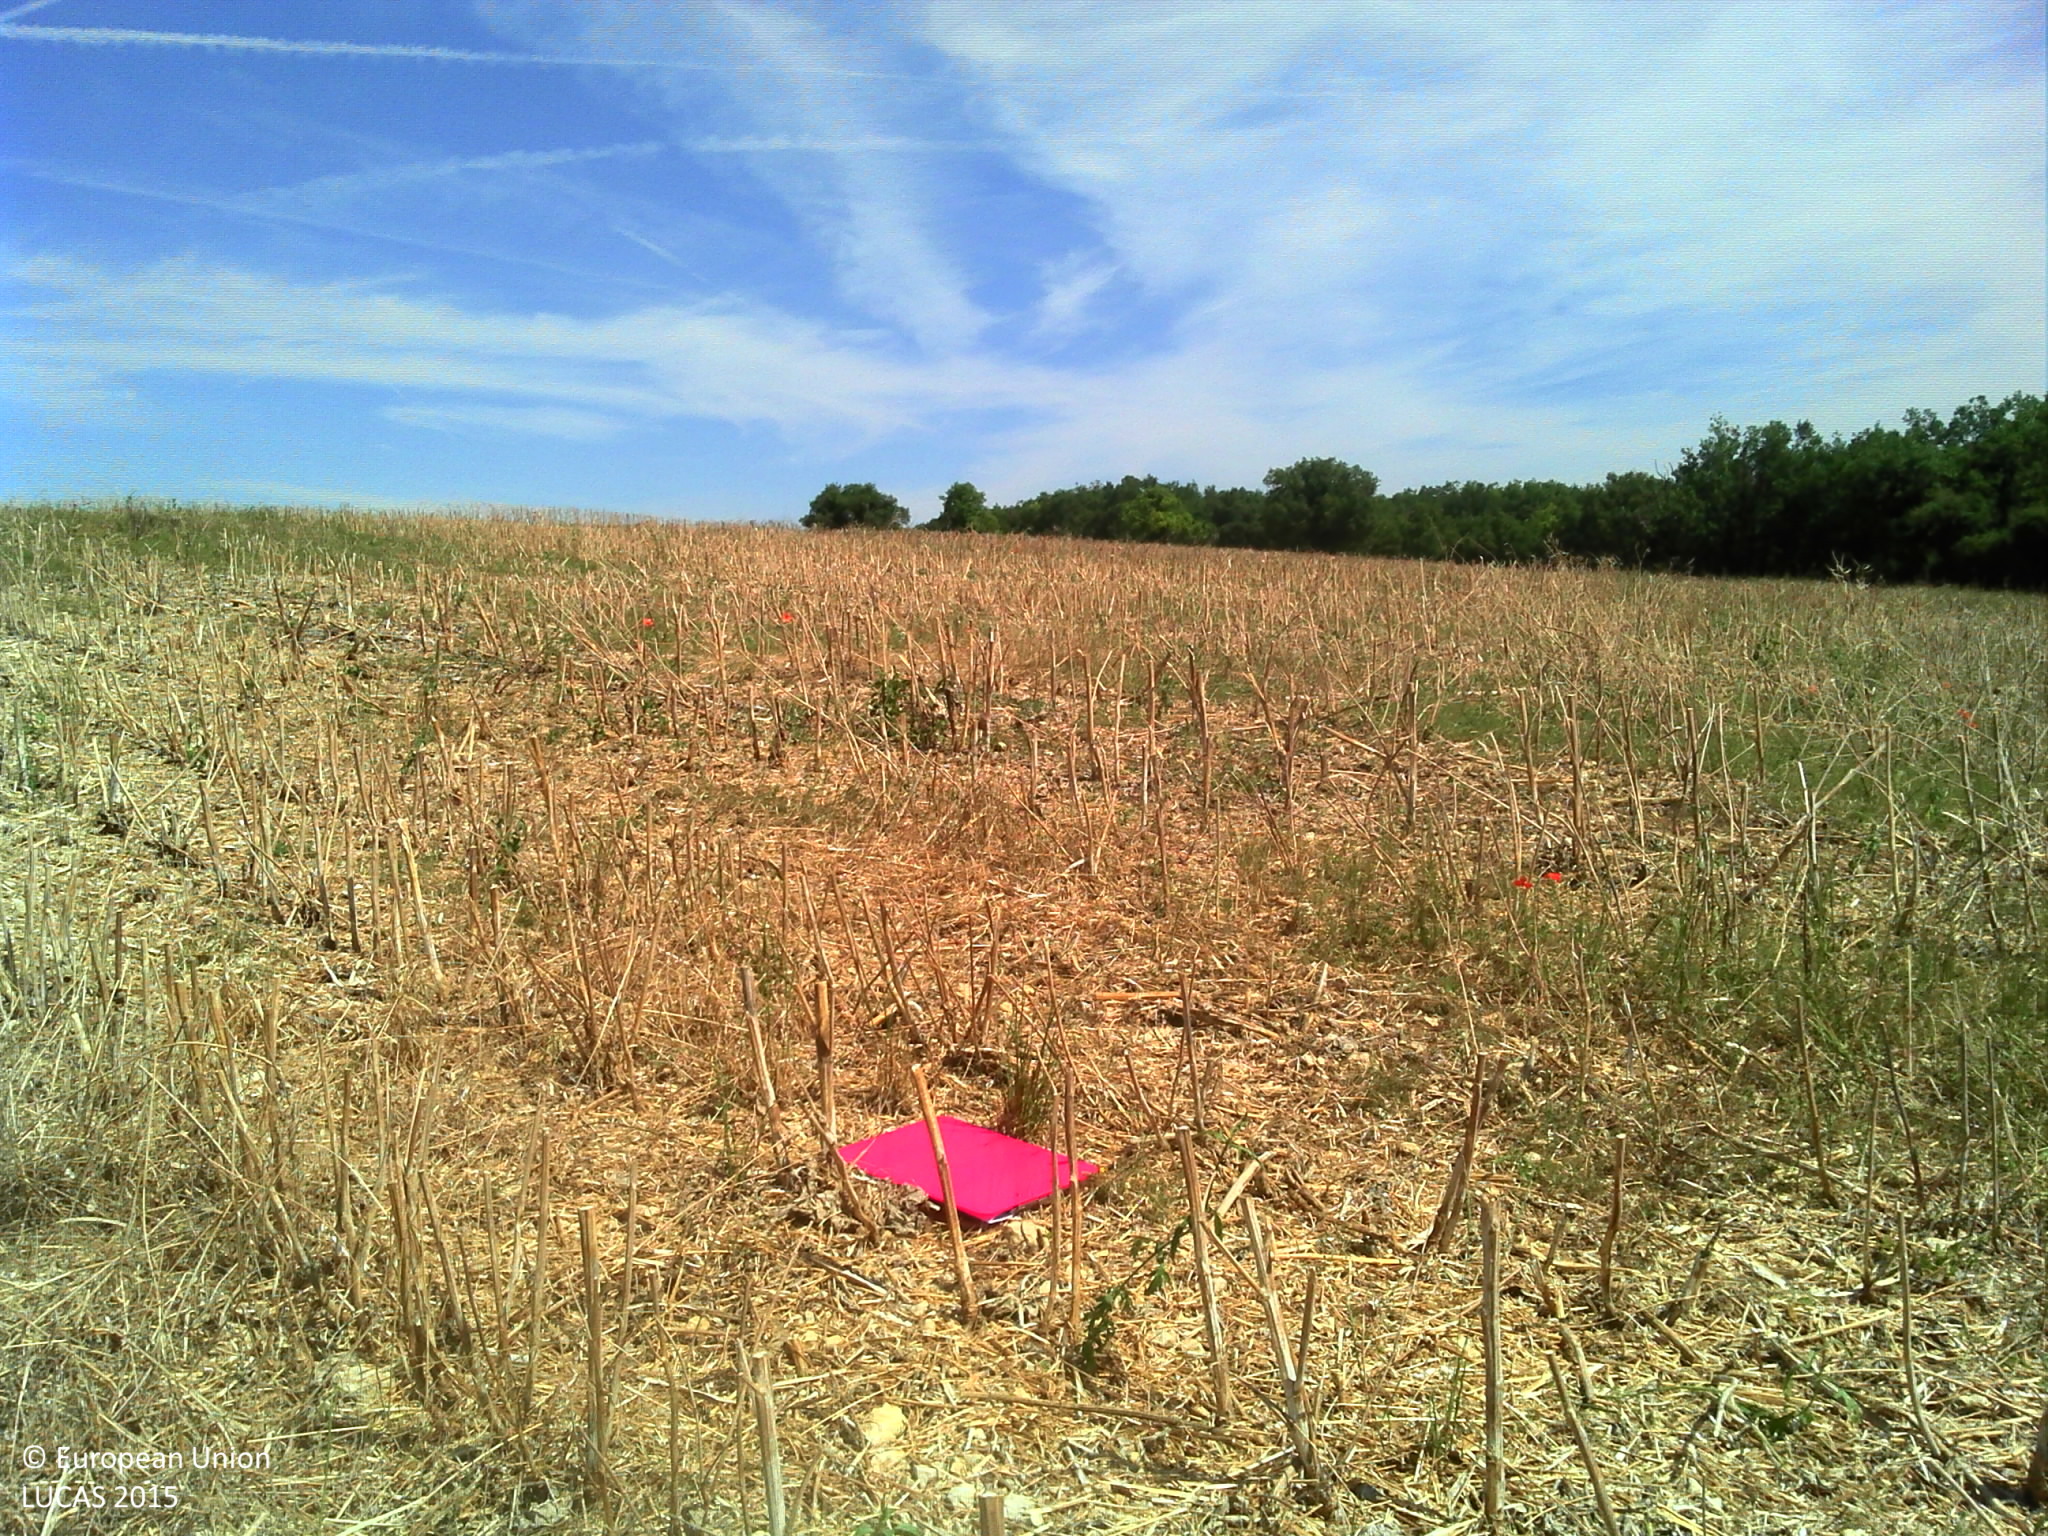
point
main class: Cropland
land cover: Rape and turnip rape
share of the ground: > 75 %
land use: Agriculture (excluding fallow land and kitchen gardens)
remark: Harvested field
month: June
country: FR
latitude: 44.0115
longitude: 2.0827
